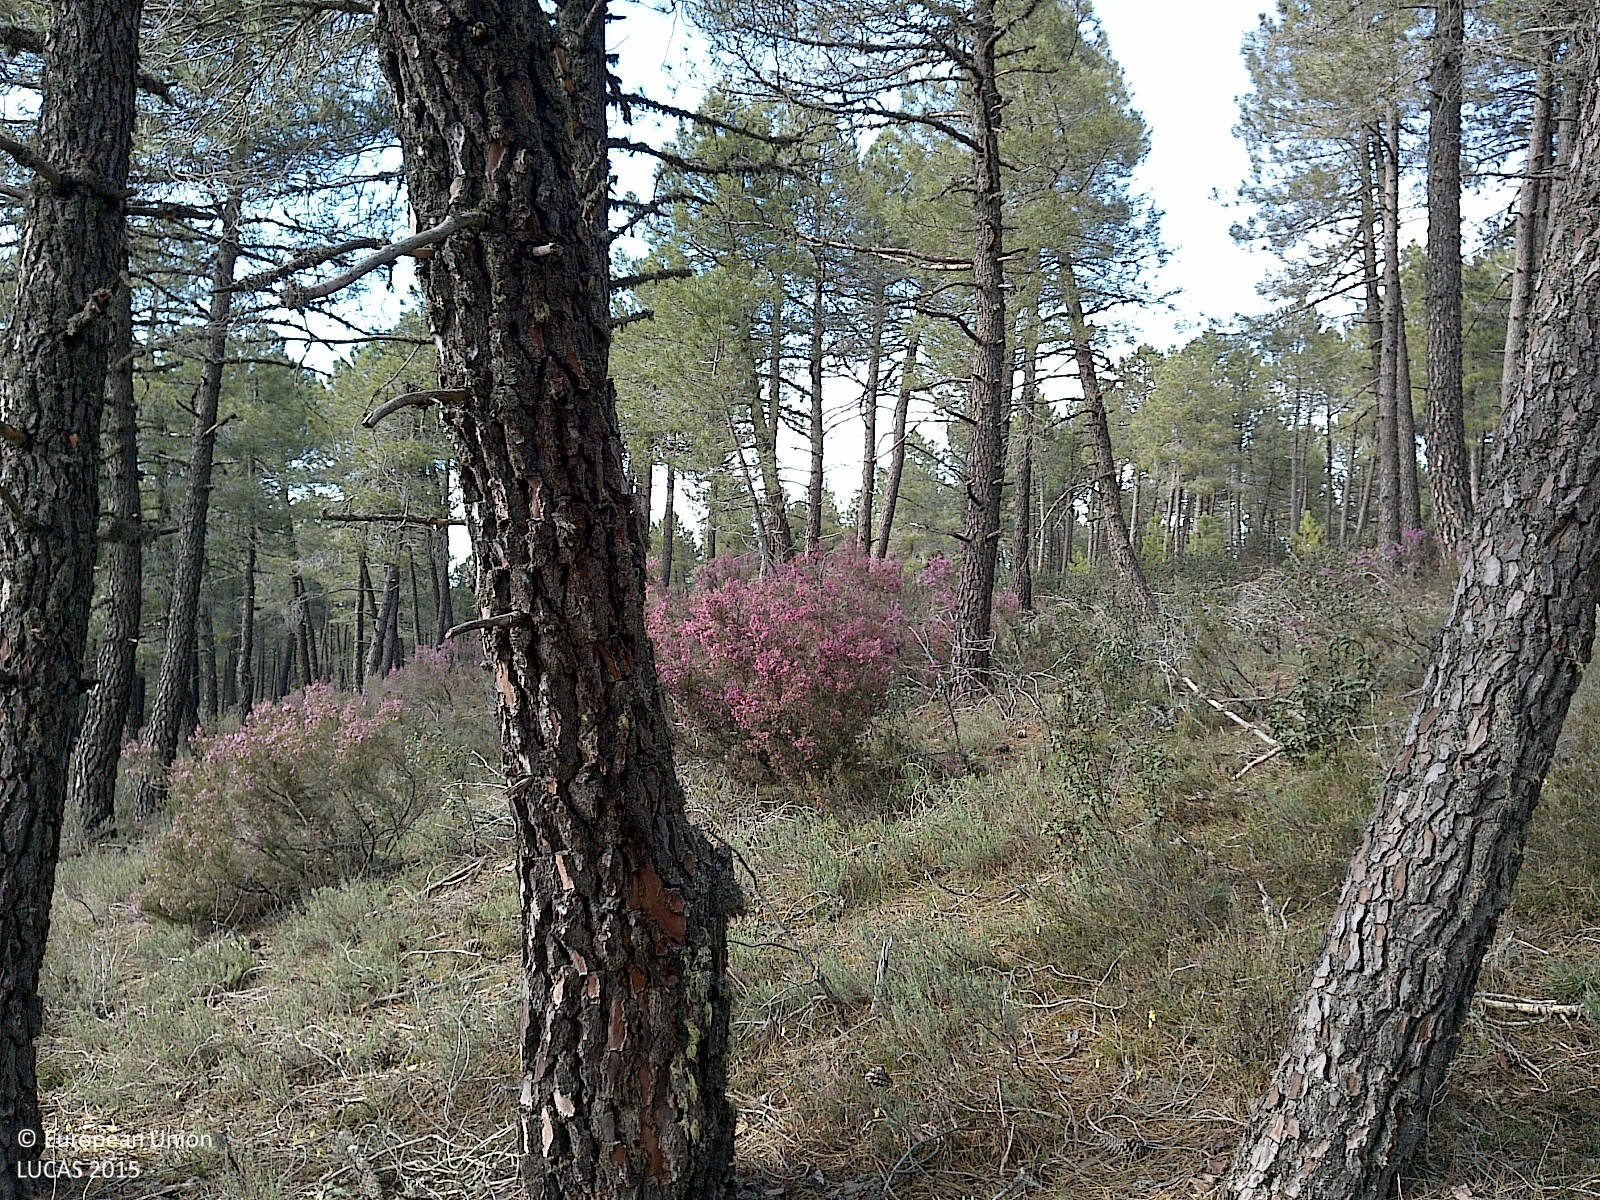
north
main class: Woodland
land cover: Pine dominated coniferous woodland
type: coniferous forest of the mediterranean region
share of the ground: 50 - 75 %
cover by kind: coniferous forest trees 55 %, shrubs 25 %, herbaceous plants 20 %
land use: Forestry
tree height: > 5 m
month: April
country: ES
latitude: 41.8686
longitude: -3.2658
